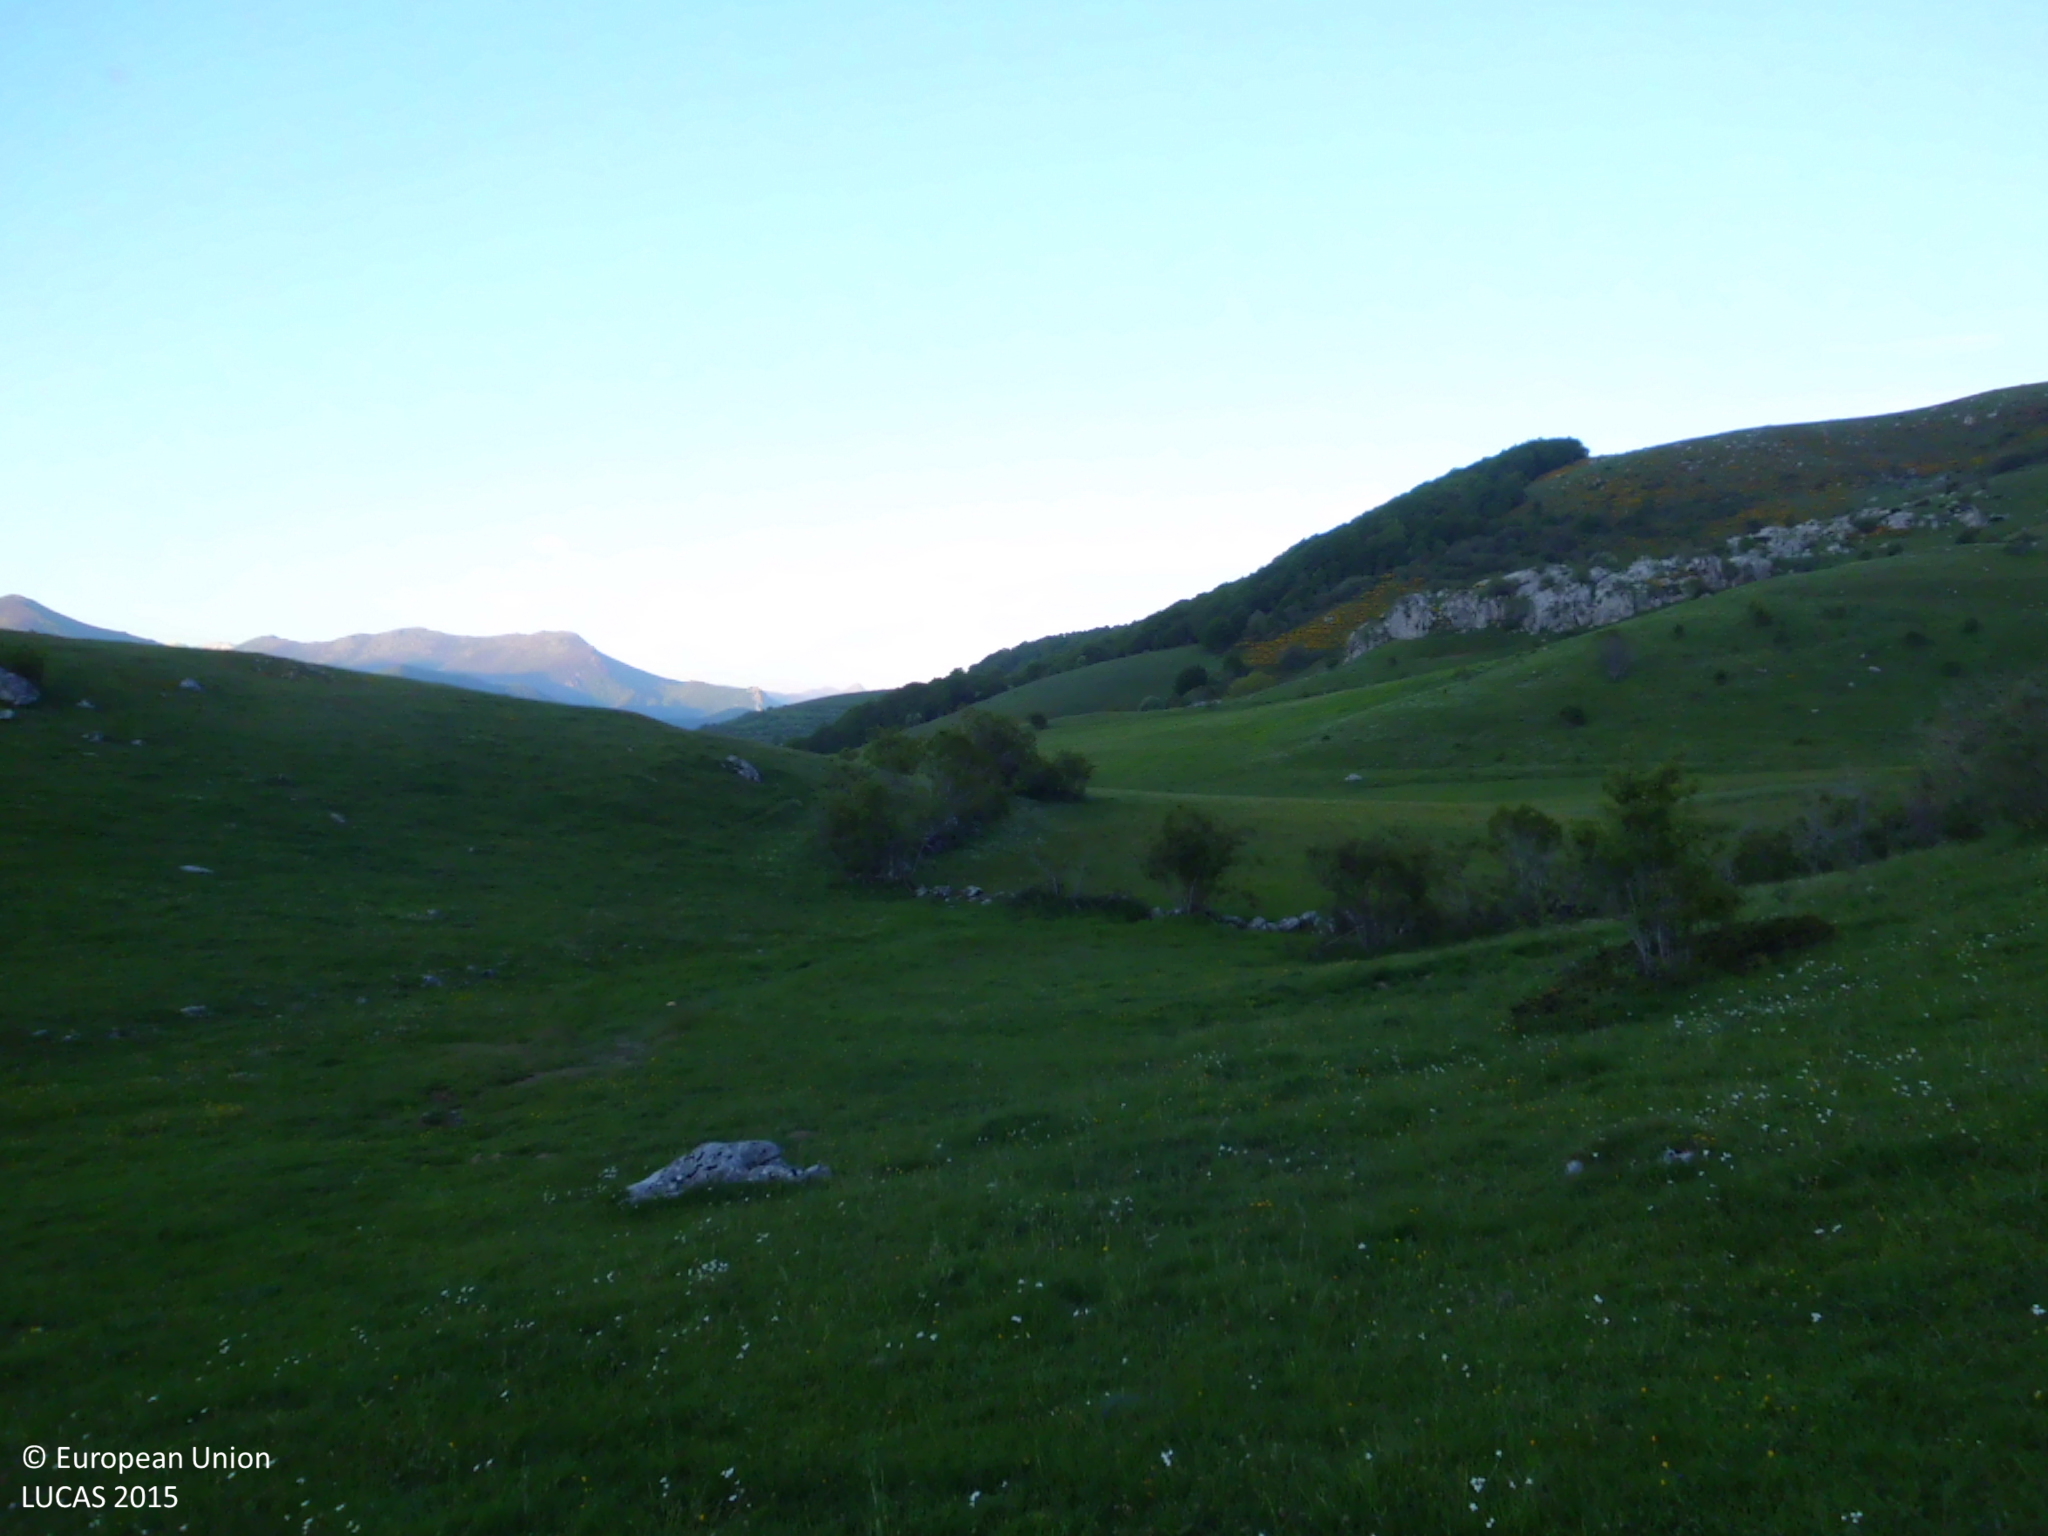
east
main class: Grassland
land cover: Grassland without tree/shrub cover
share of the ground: > 75 %
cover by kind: herbaceous plants 100 %
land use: Agriculture (excluding fallow land and kitchen gardens)
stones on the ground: < 10 %
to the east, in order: Grassland without tree/shrub cover
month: May
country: ES
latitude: 43.0426
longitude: -5.1807
